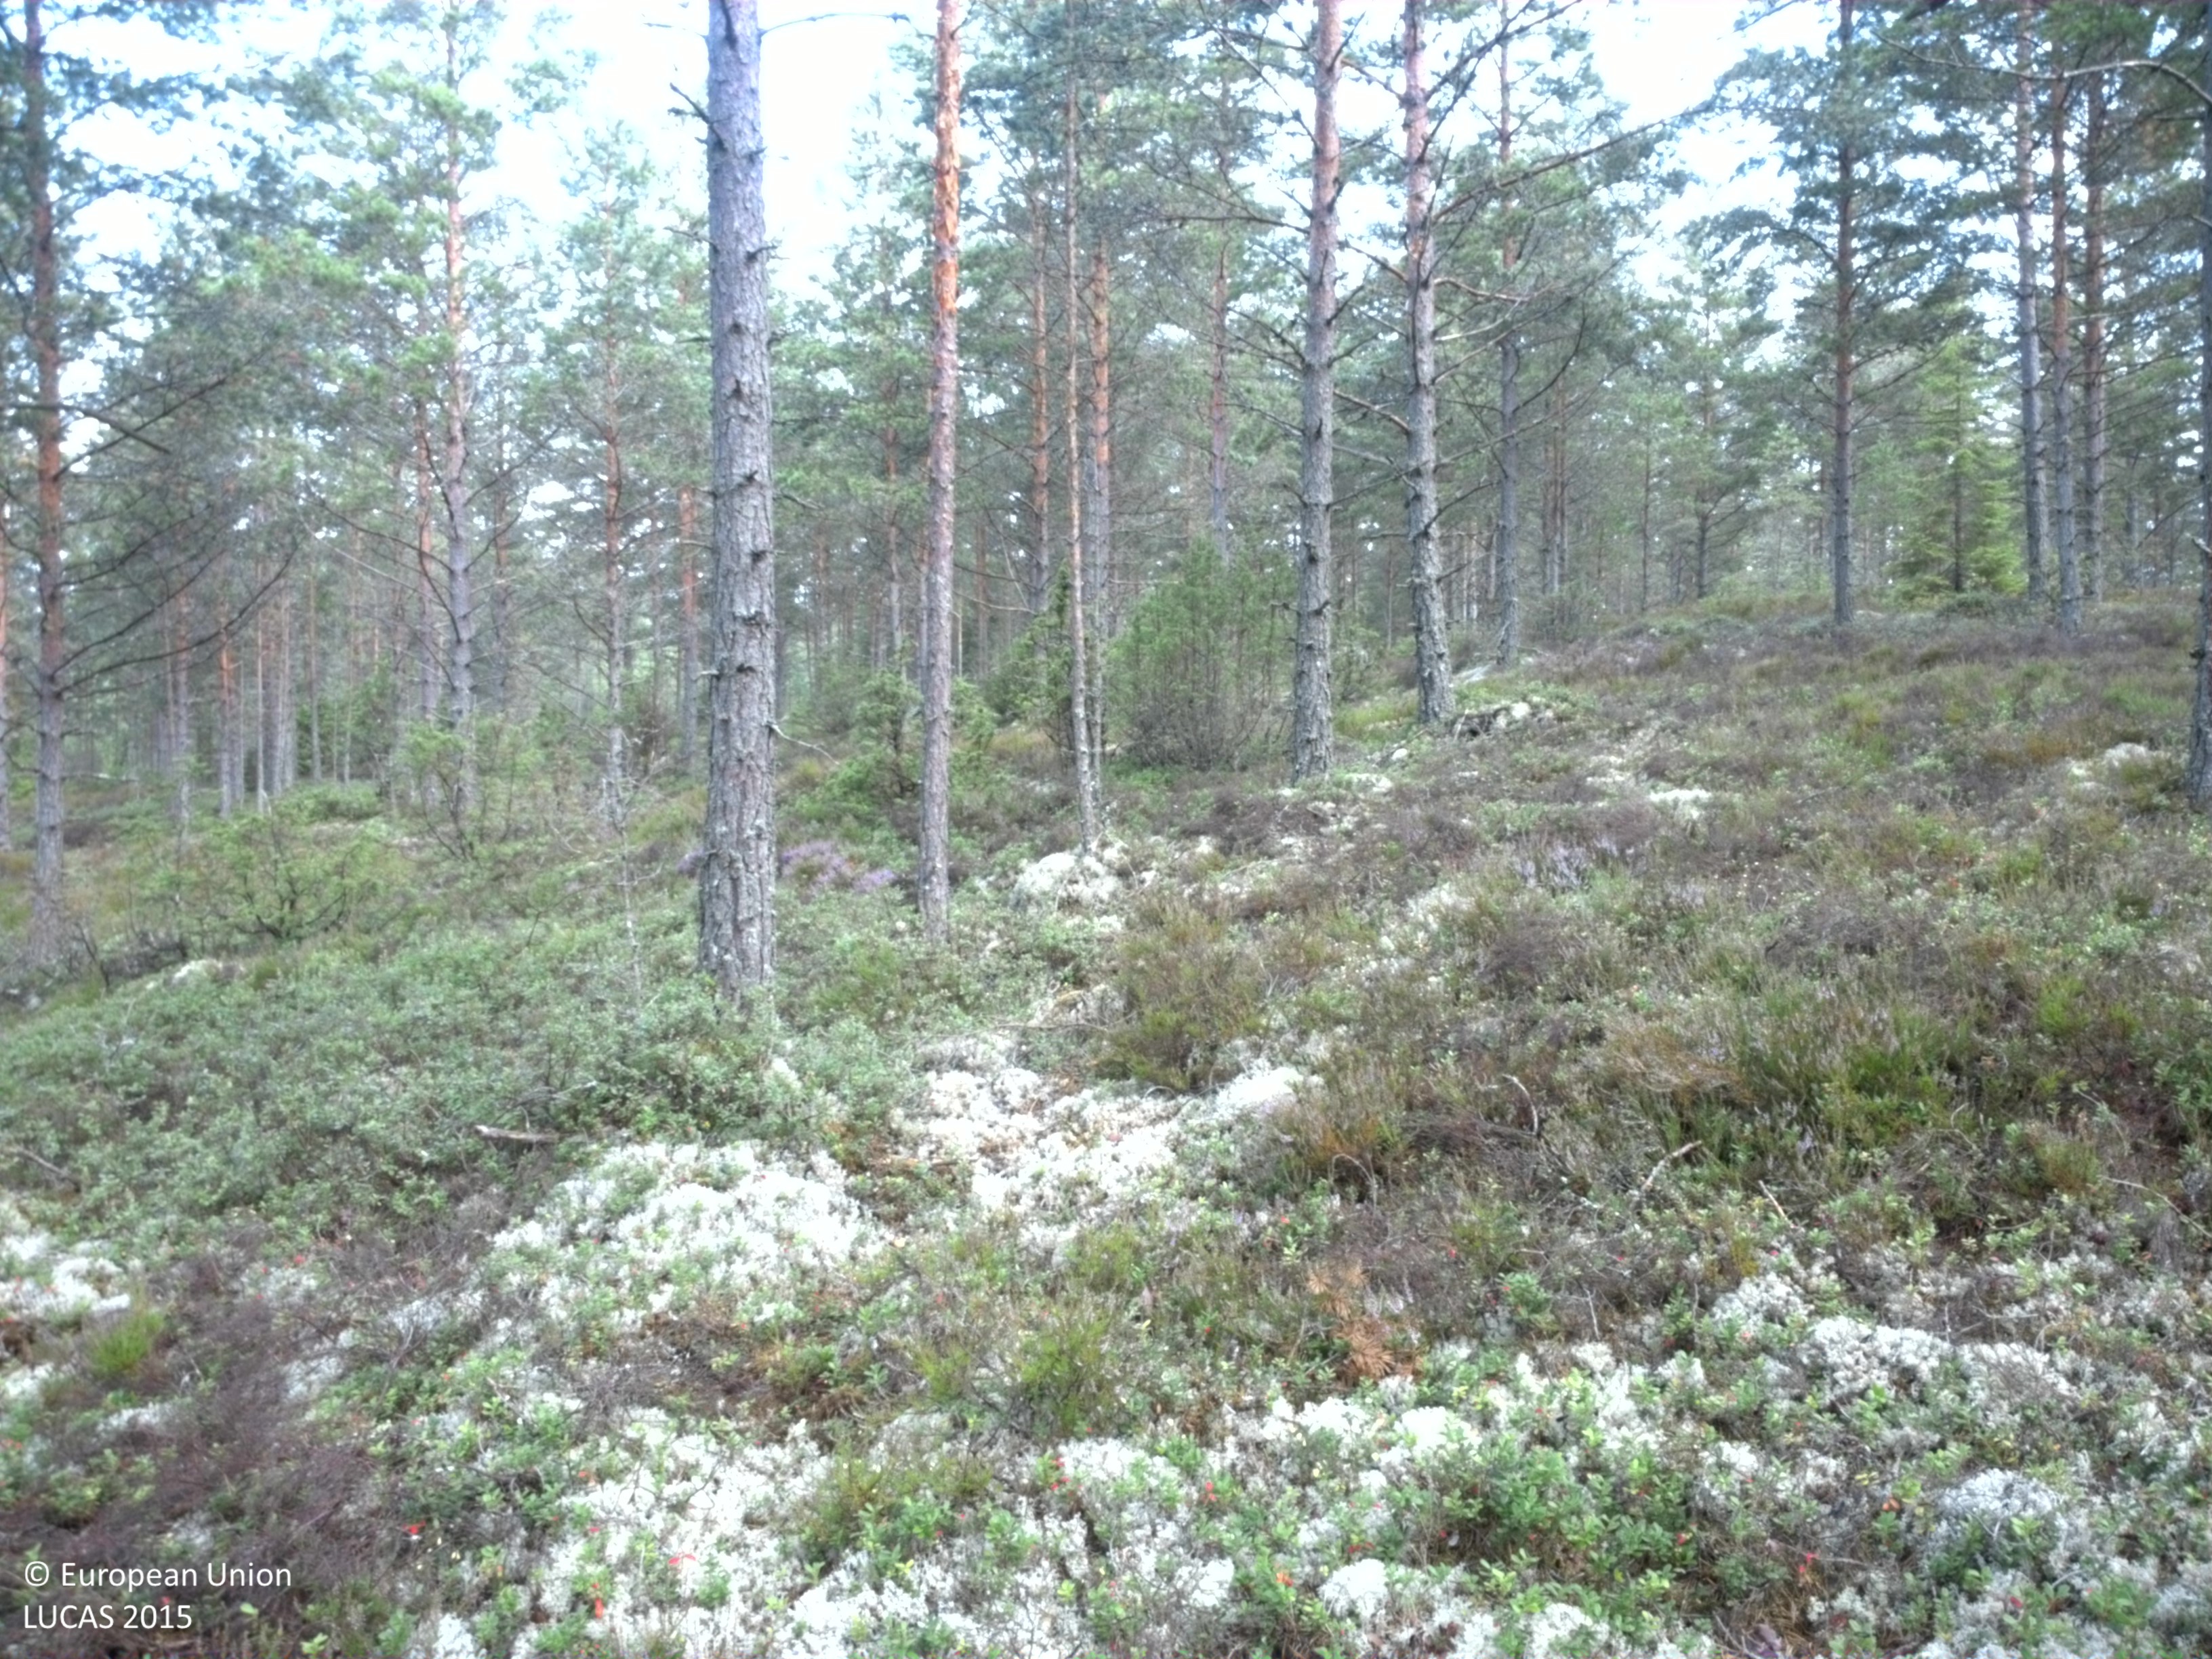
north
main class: Woodland
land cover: Pine dominated coniferous woodland
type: boreal forest
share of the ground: 50 - 75 %
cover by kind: coniferous forest trees 65 %, shrubs 20 %, lichens and mosses 10 %, broadleaved forest trees 5 %
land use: Forestry
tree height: > 5 m
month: August
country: SE
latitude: 59.3400
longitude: 11.8764
